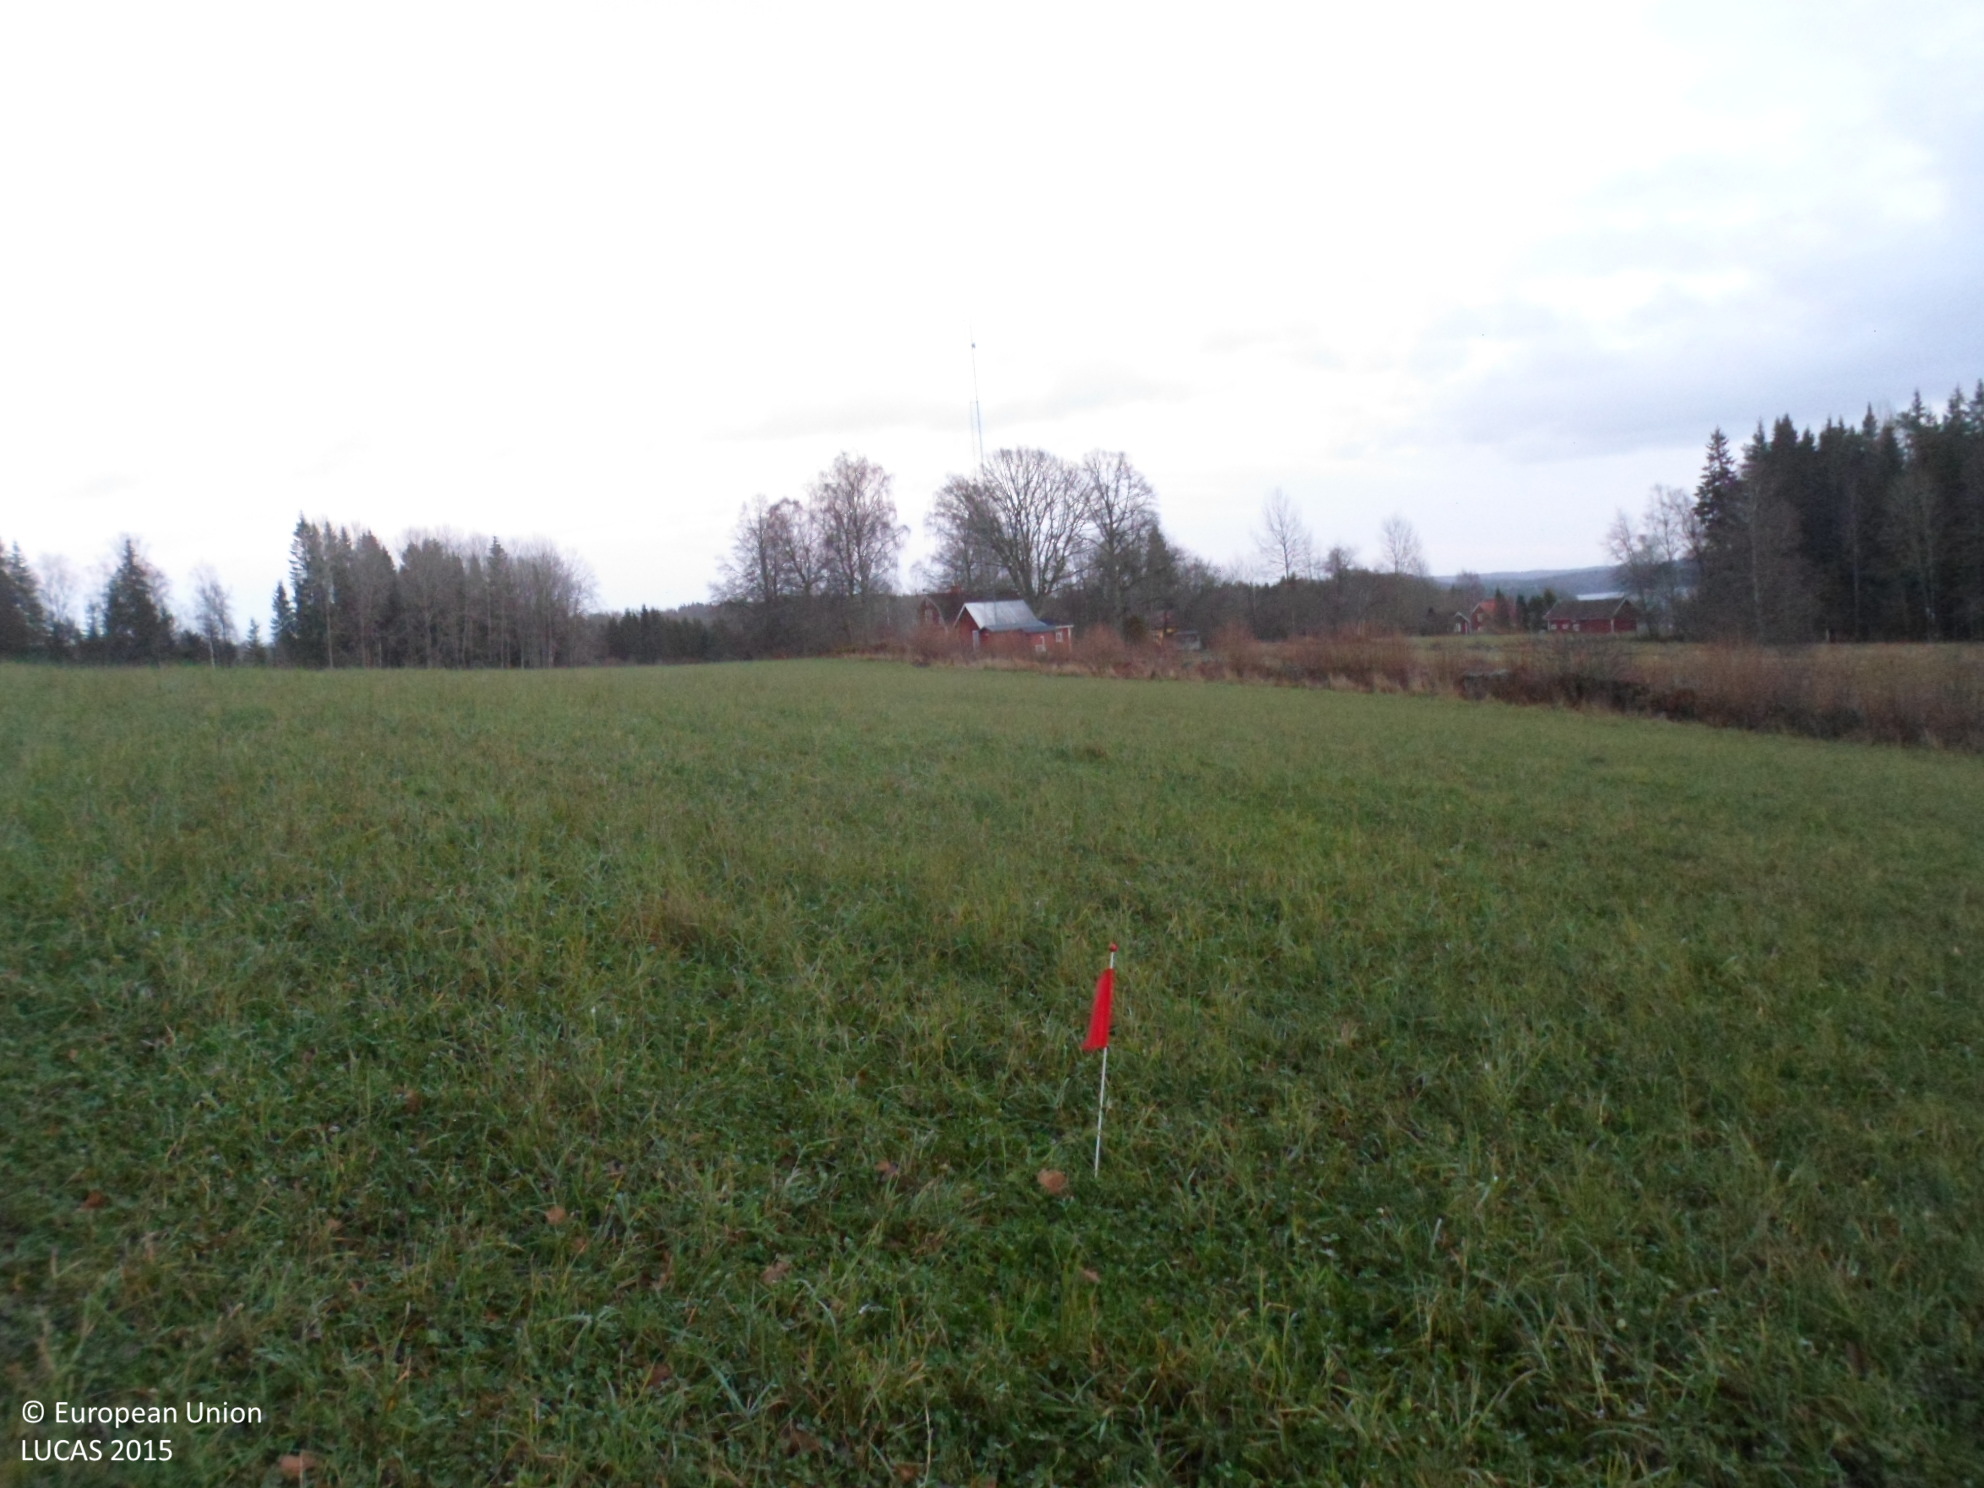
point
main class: Grassland
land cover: Grassland without tree/shrub cover
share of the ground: > 75 %
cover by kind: herbaceous plants 100 %
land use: Agriculture (excluding fallow land and kitchen gardens)
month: November
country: SE
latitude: 57.5949
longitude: 15.2328
